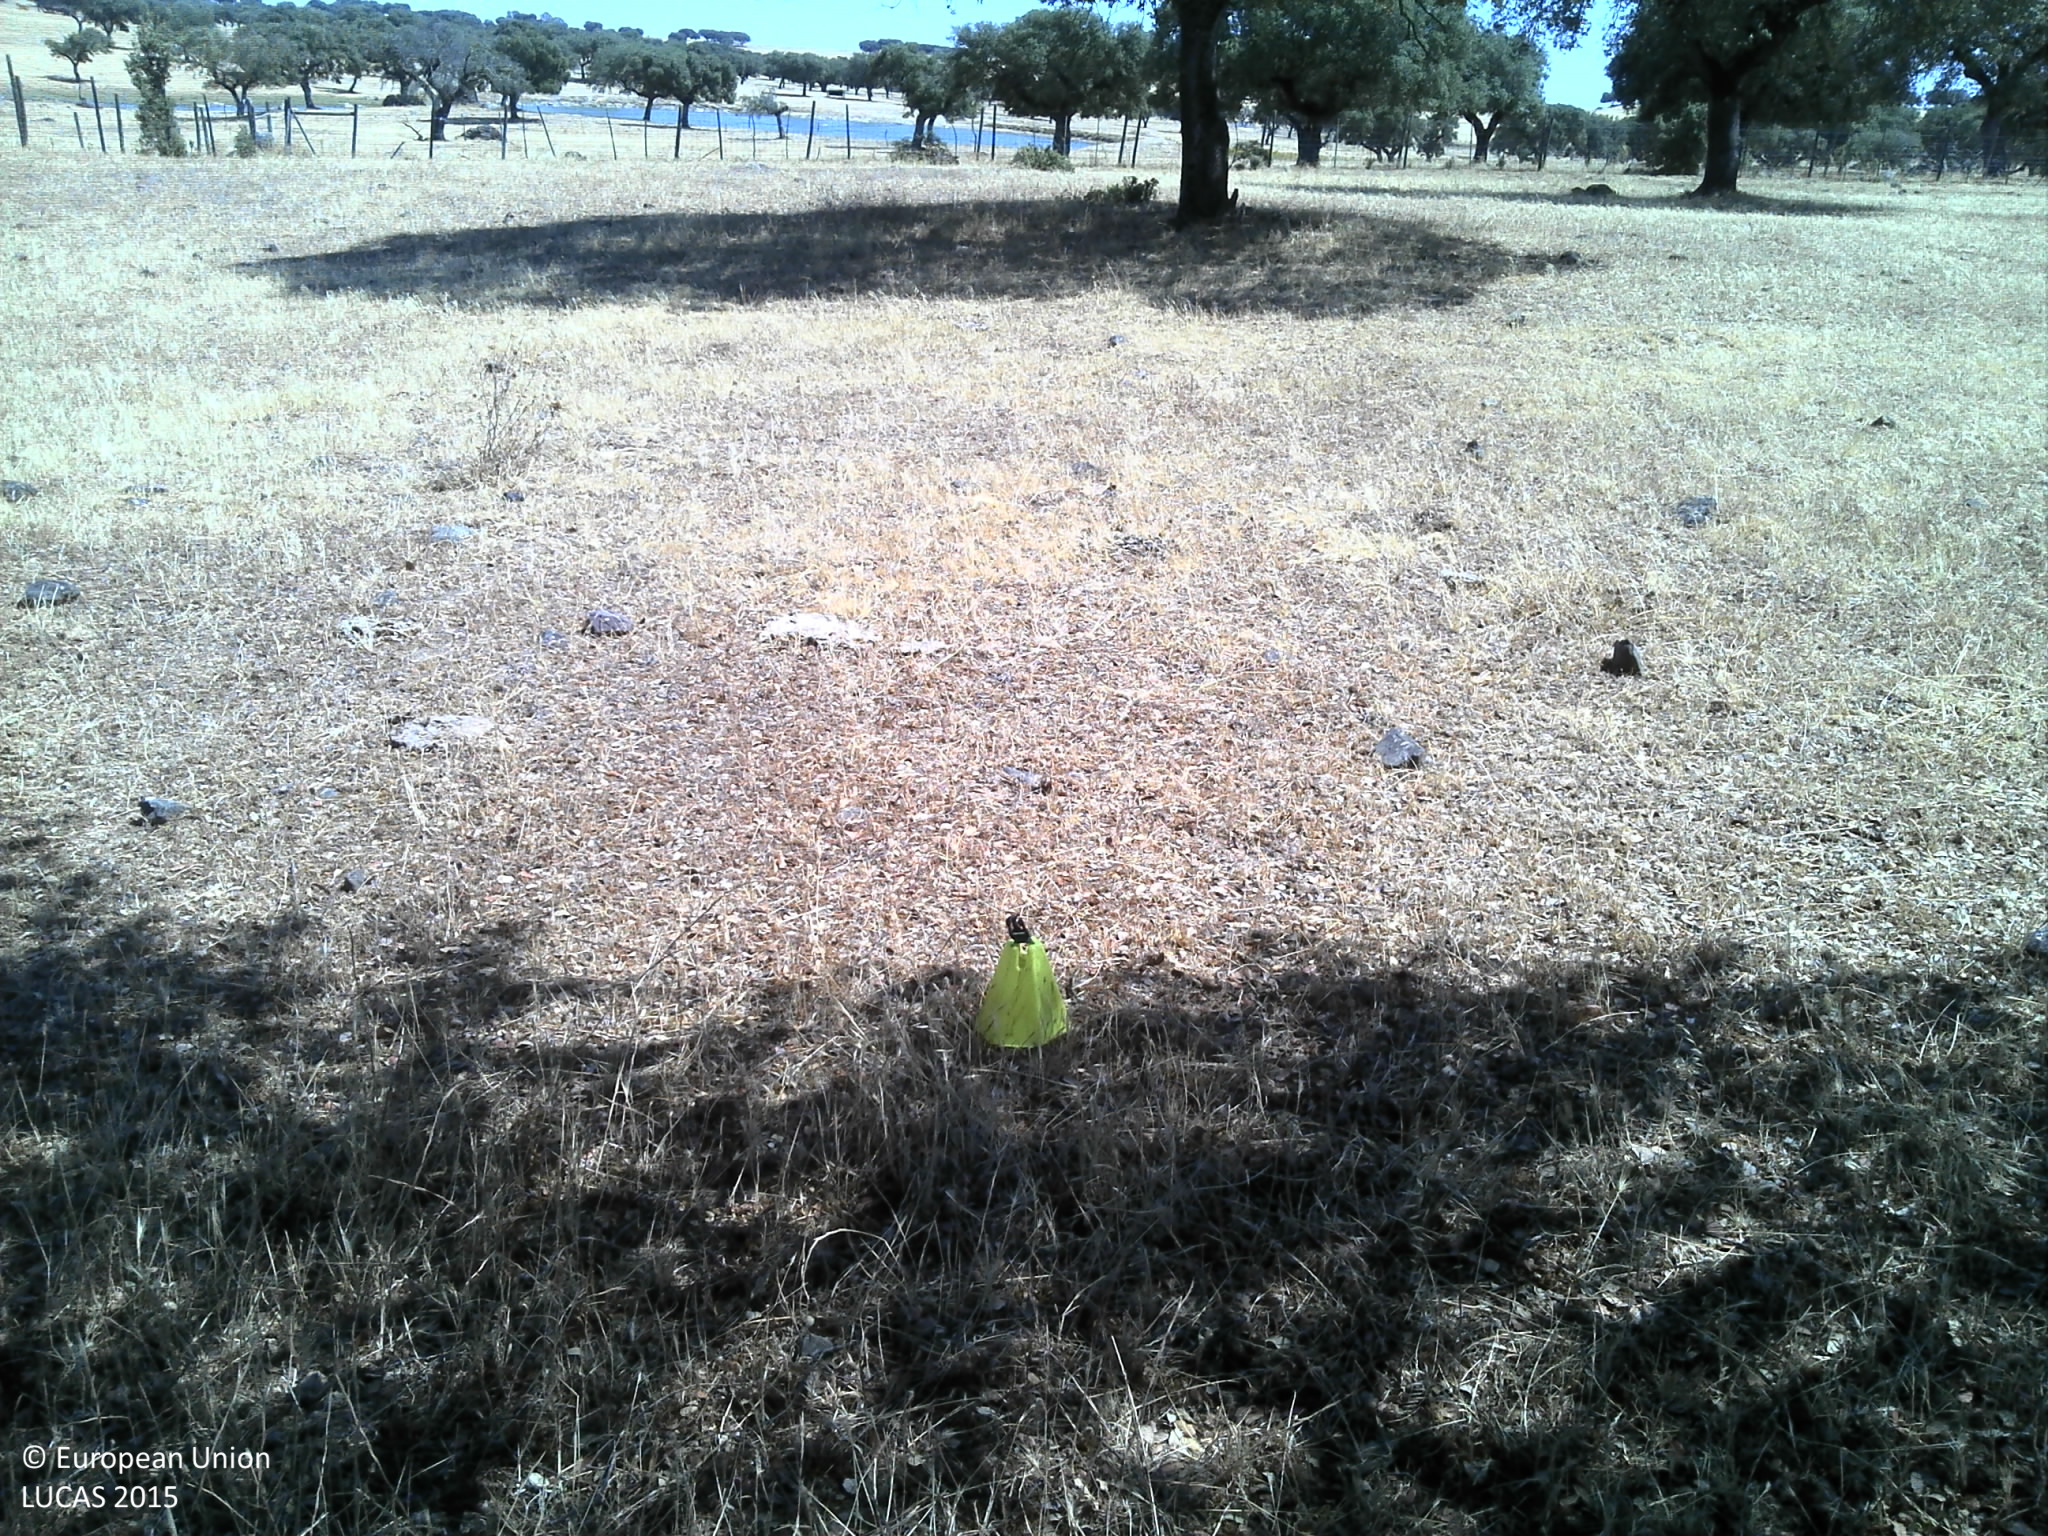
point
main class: Woodland
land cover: Broadleaved woodland
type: broadleaved evergreen forest
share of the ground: 10 - 25 %
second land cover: Grassland without tree/shrub cover
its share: 10 - 25 %
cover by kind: unconsolidated bare surface 60 %, broadleaved forest trees 20 %, herbaceous plants 20 %
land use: Forestry
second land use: Agriculture (excluding fallow land and kitchen gardens)
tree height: > 5 m
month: July
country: PT
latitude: 38.8028
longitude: -7.3372
